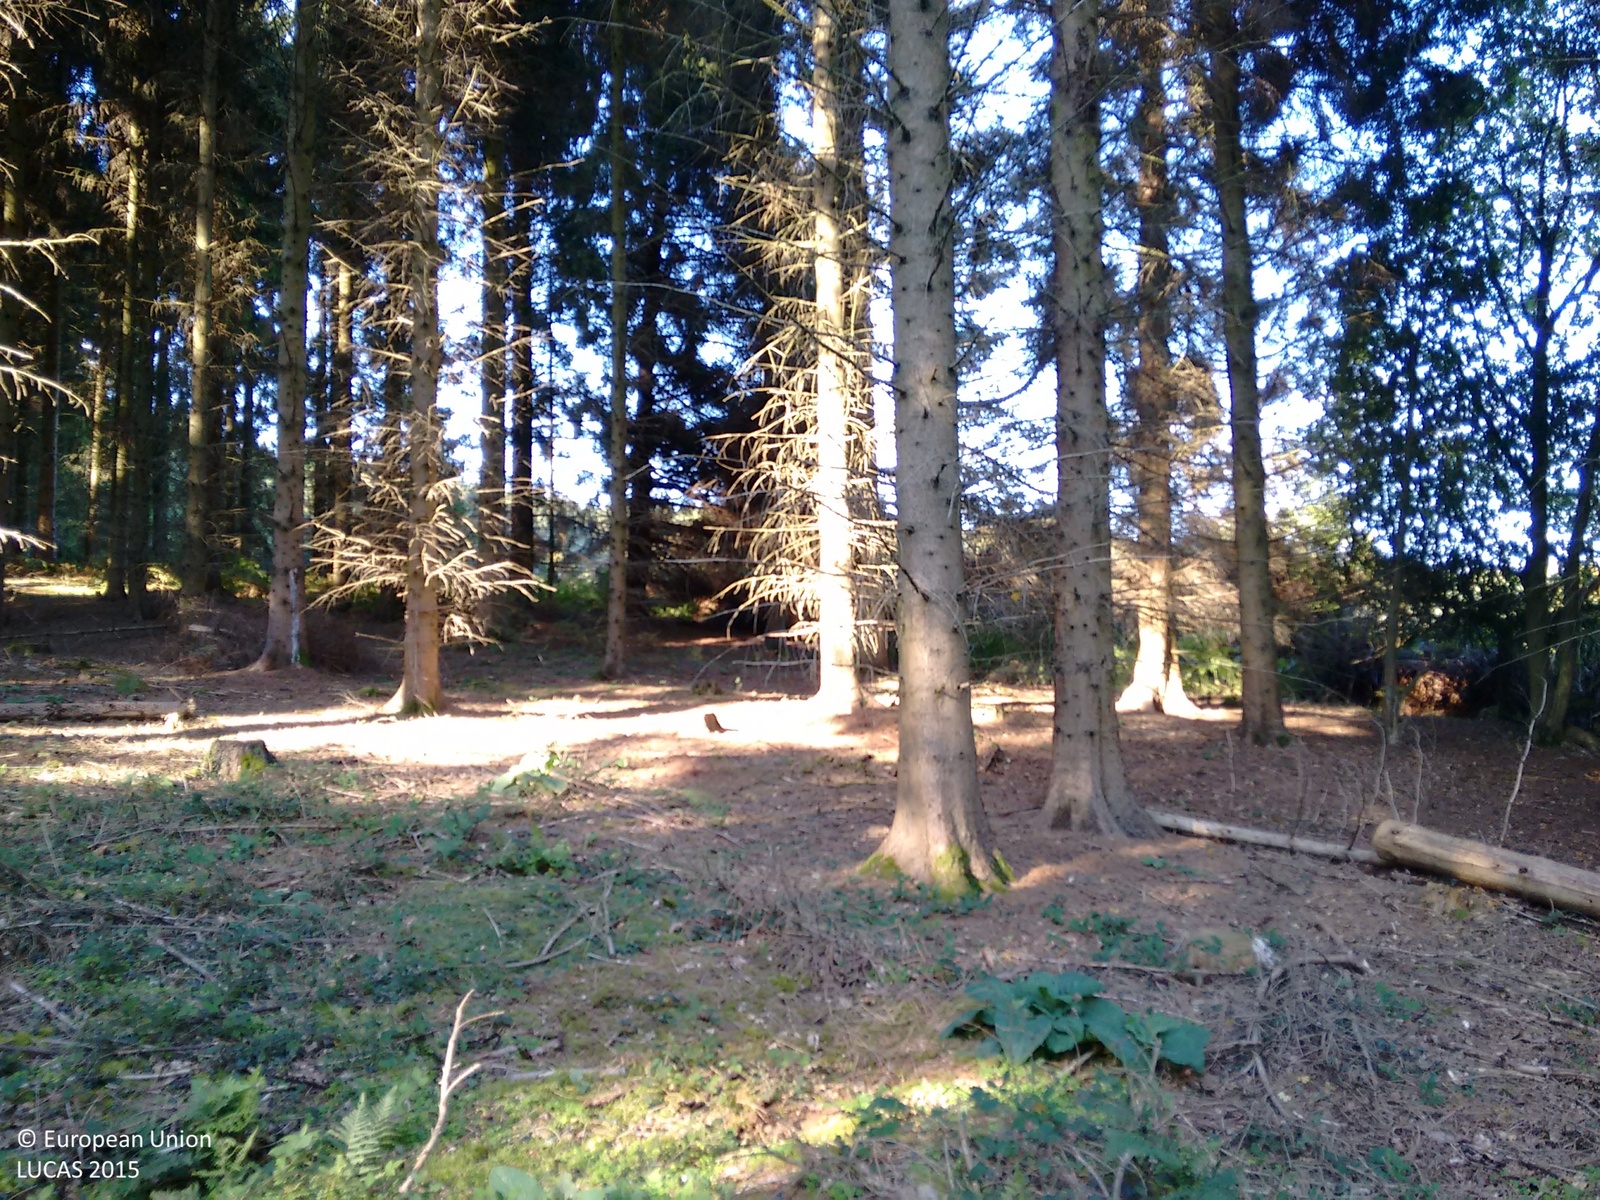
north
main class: Woodland
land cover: Spruce dominated coniferous woodland
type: exotic forest
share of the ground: > 75 %
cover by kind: coniferous forest trees 70 %, herbaceous plants 30 %
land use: Forestry
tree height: > 5 m
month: September
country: GB
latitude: 51.8373
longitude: -2.5338
